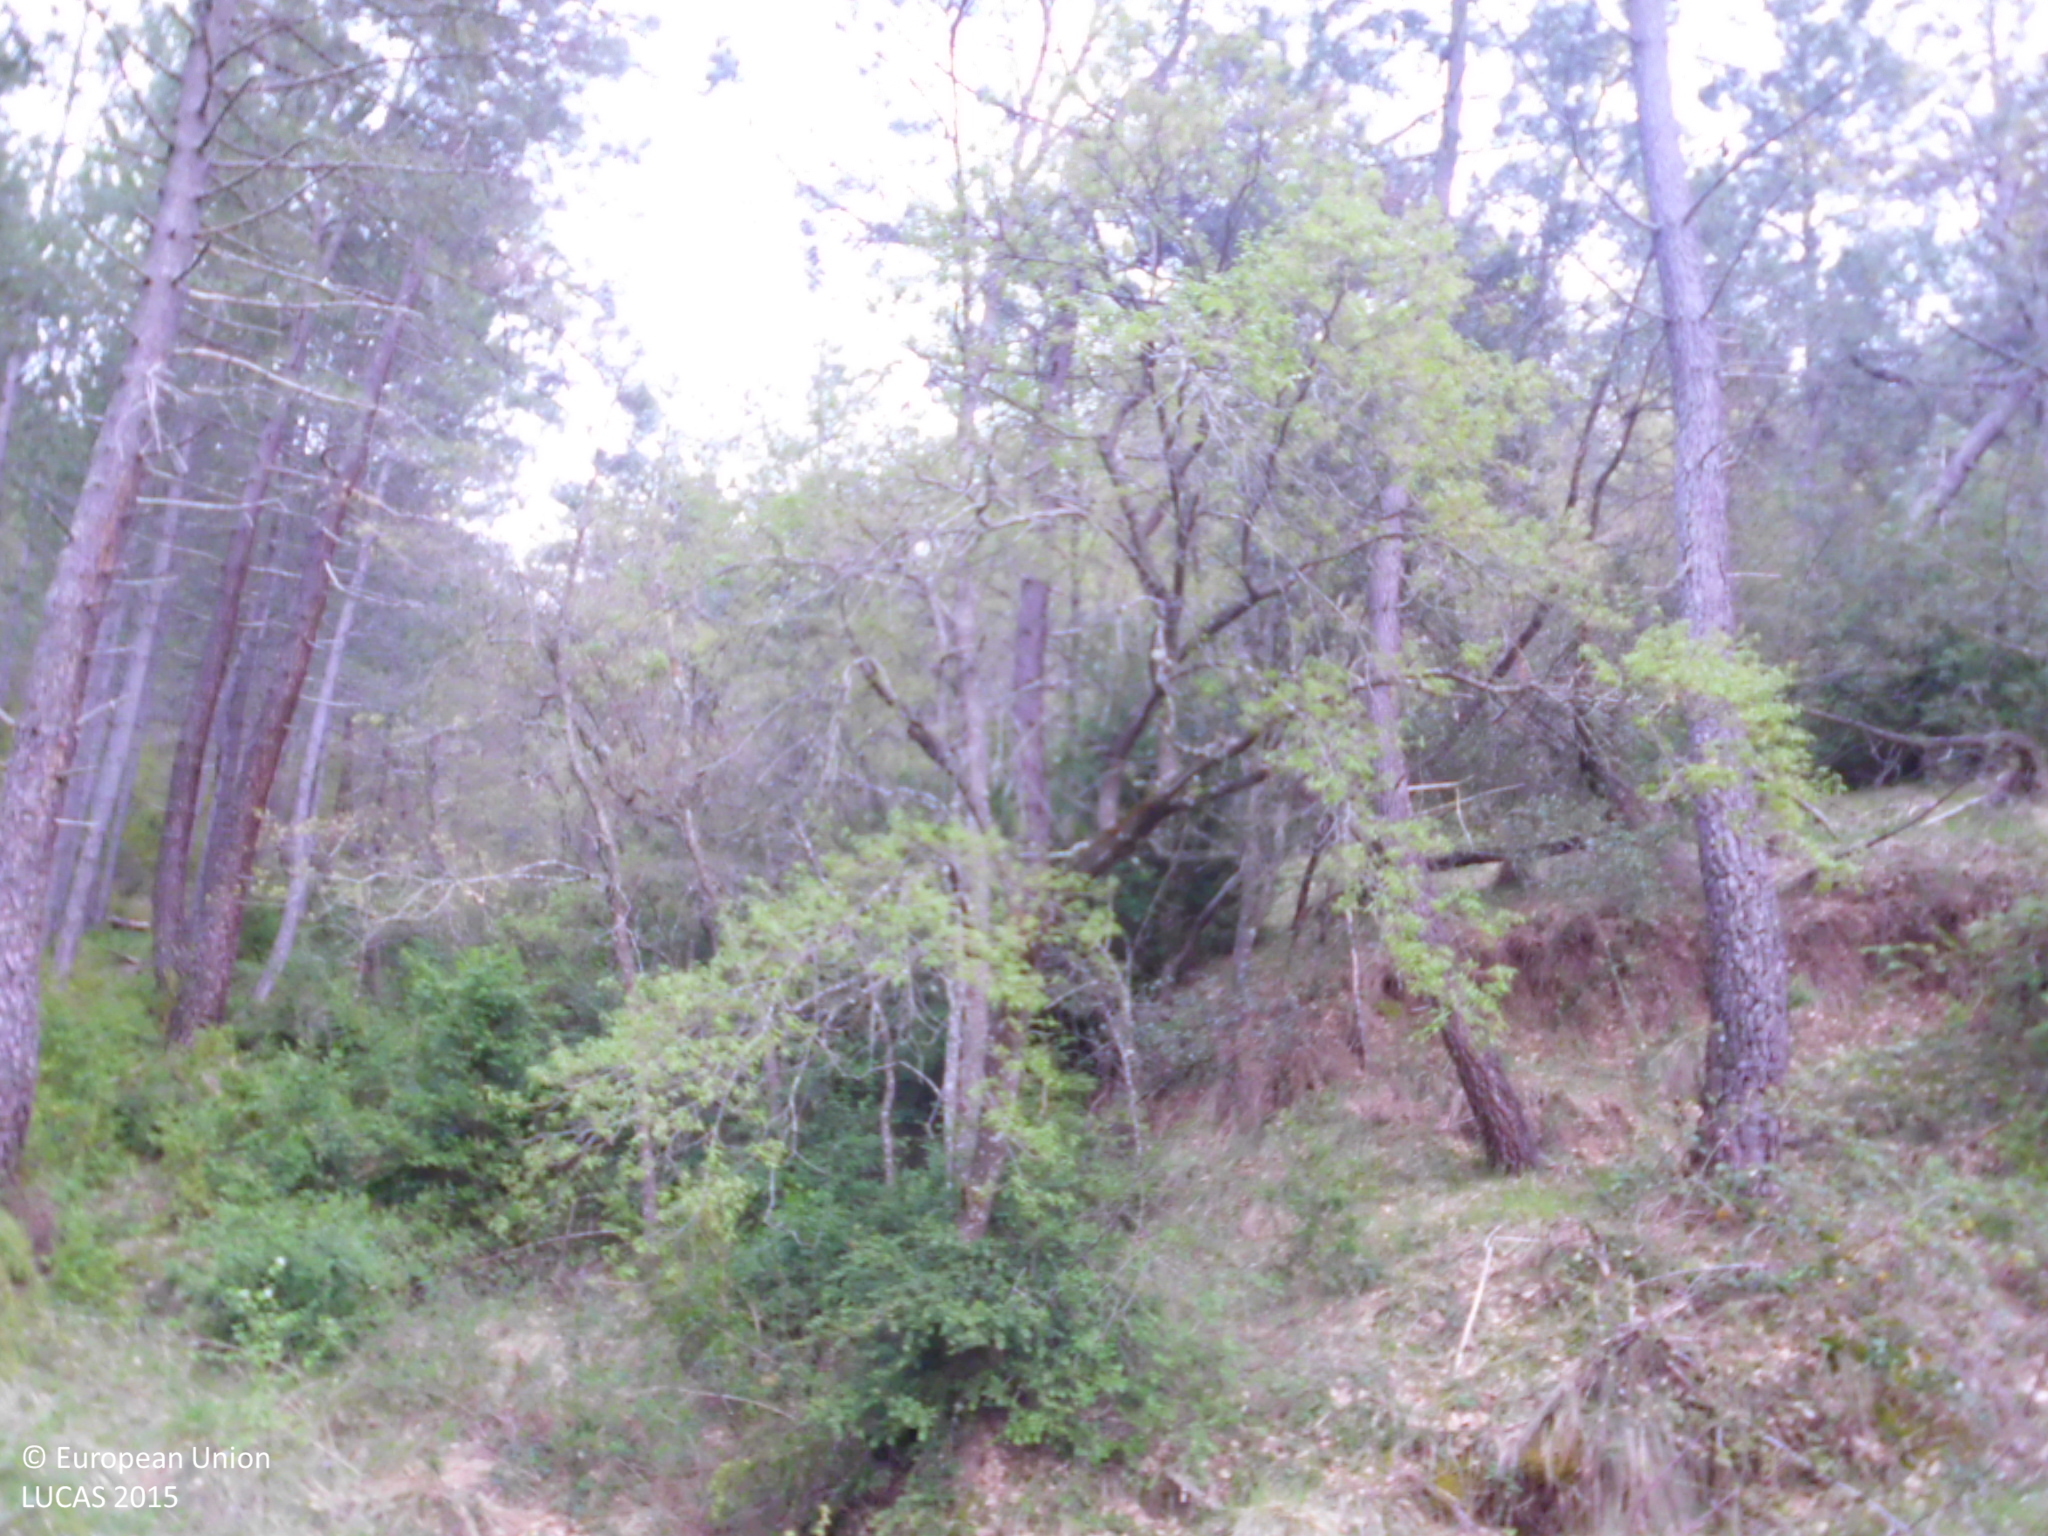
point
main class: Woodland
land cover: Pine dominated mixed woodland
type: coniferous forest of the mediterranean region
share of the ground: > 75 %
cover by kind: coniferous forest trees 55 %, broadleaved forest trees 20 %, shrubs 15 %, herbaceous plants 10 %
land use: Semi-natural and natural areas not in use
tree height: > 5 m
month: April
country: ES
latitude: 42.7945
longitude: -3.4491
